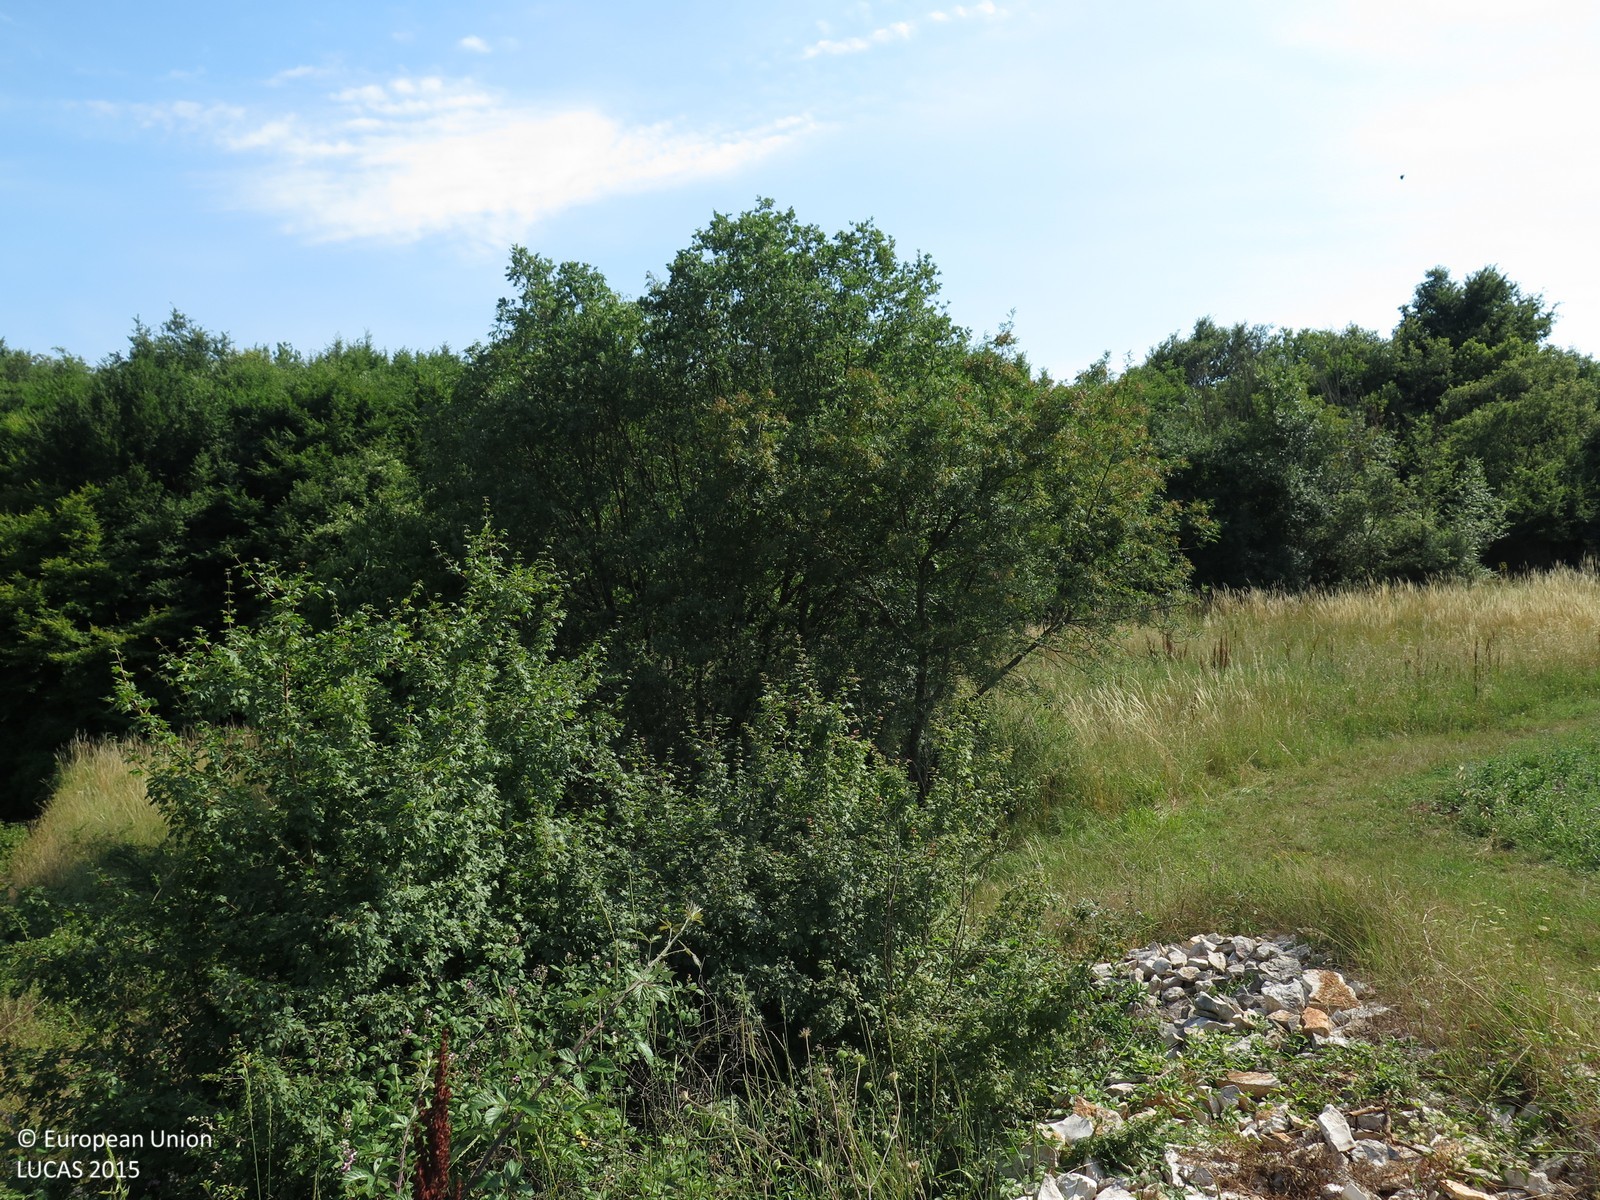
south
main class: Shrubland
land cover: Shrubland with sparse tree cover
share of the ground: > 75 %
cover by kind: shrubs 75 %, herbaceous plants 15 %, broadleaved forest trees 5 %, unconsolidated bare surface 5 %
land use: Semi-natural and natural areas not in use
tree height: > 5 m
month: June
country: HR
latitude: 45.1816
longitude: 13.8507
